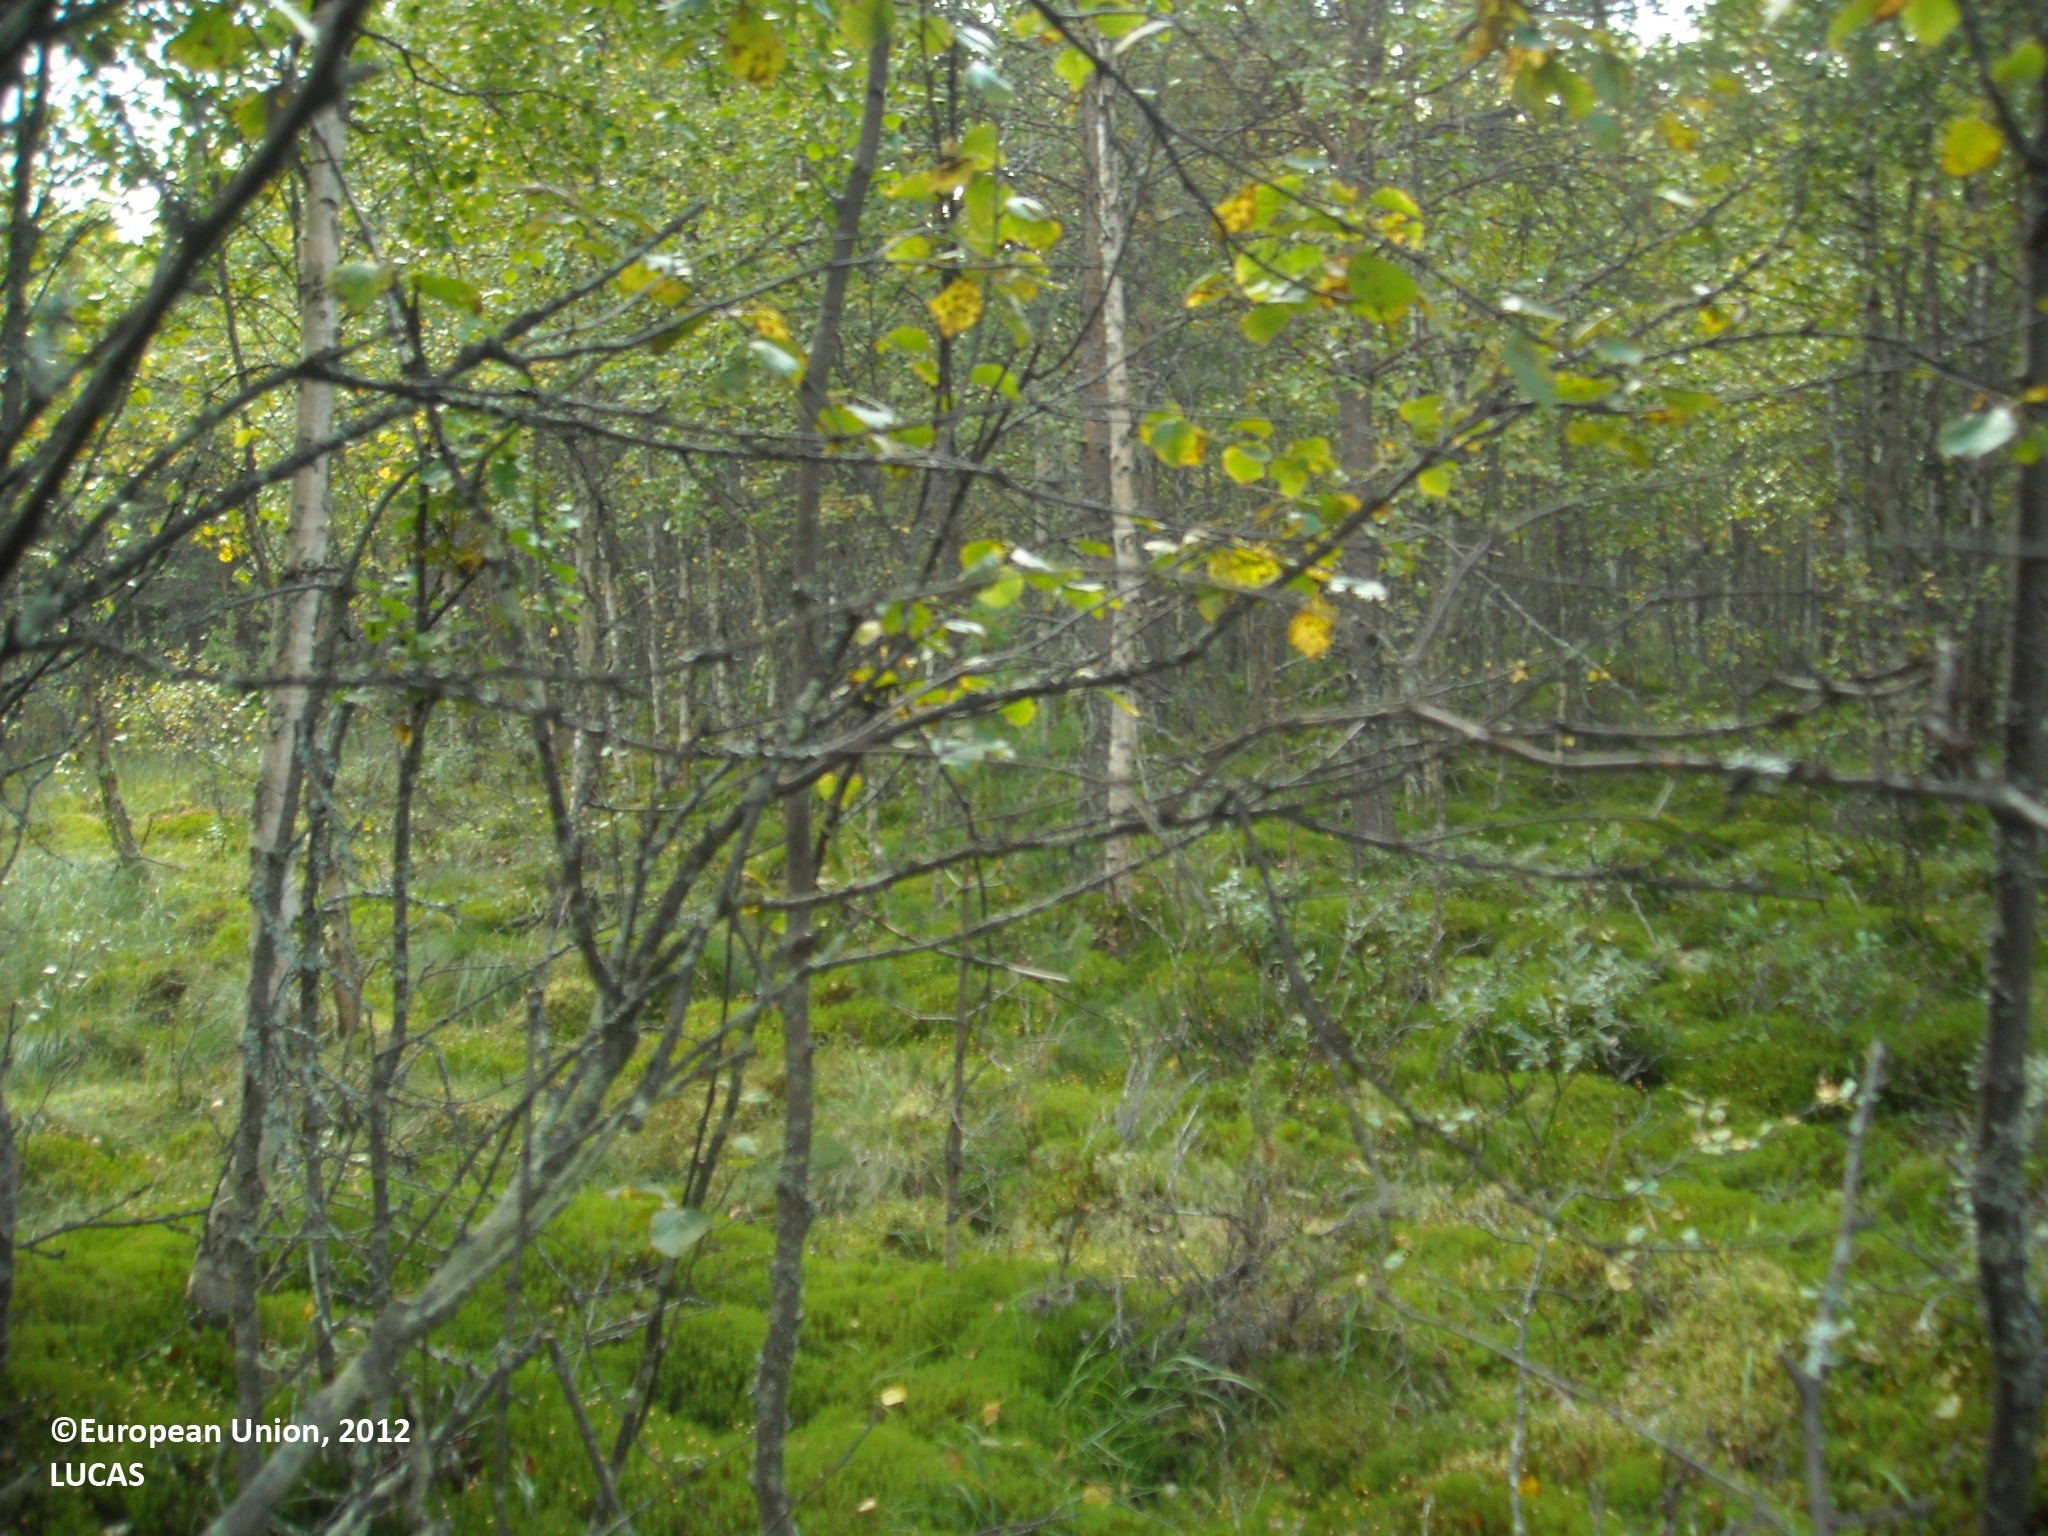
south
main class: Woodland
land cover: Broadleaved woodland
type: boreal forest
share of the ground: > 75 %
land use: Forestry
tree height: > 5 m
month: August
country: FI
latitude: 66.0990
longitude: 26.9370
